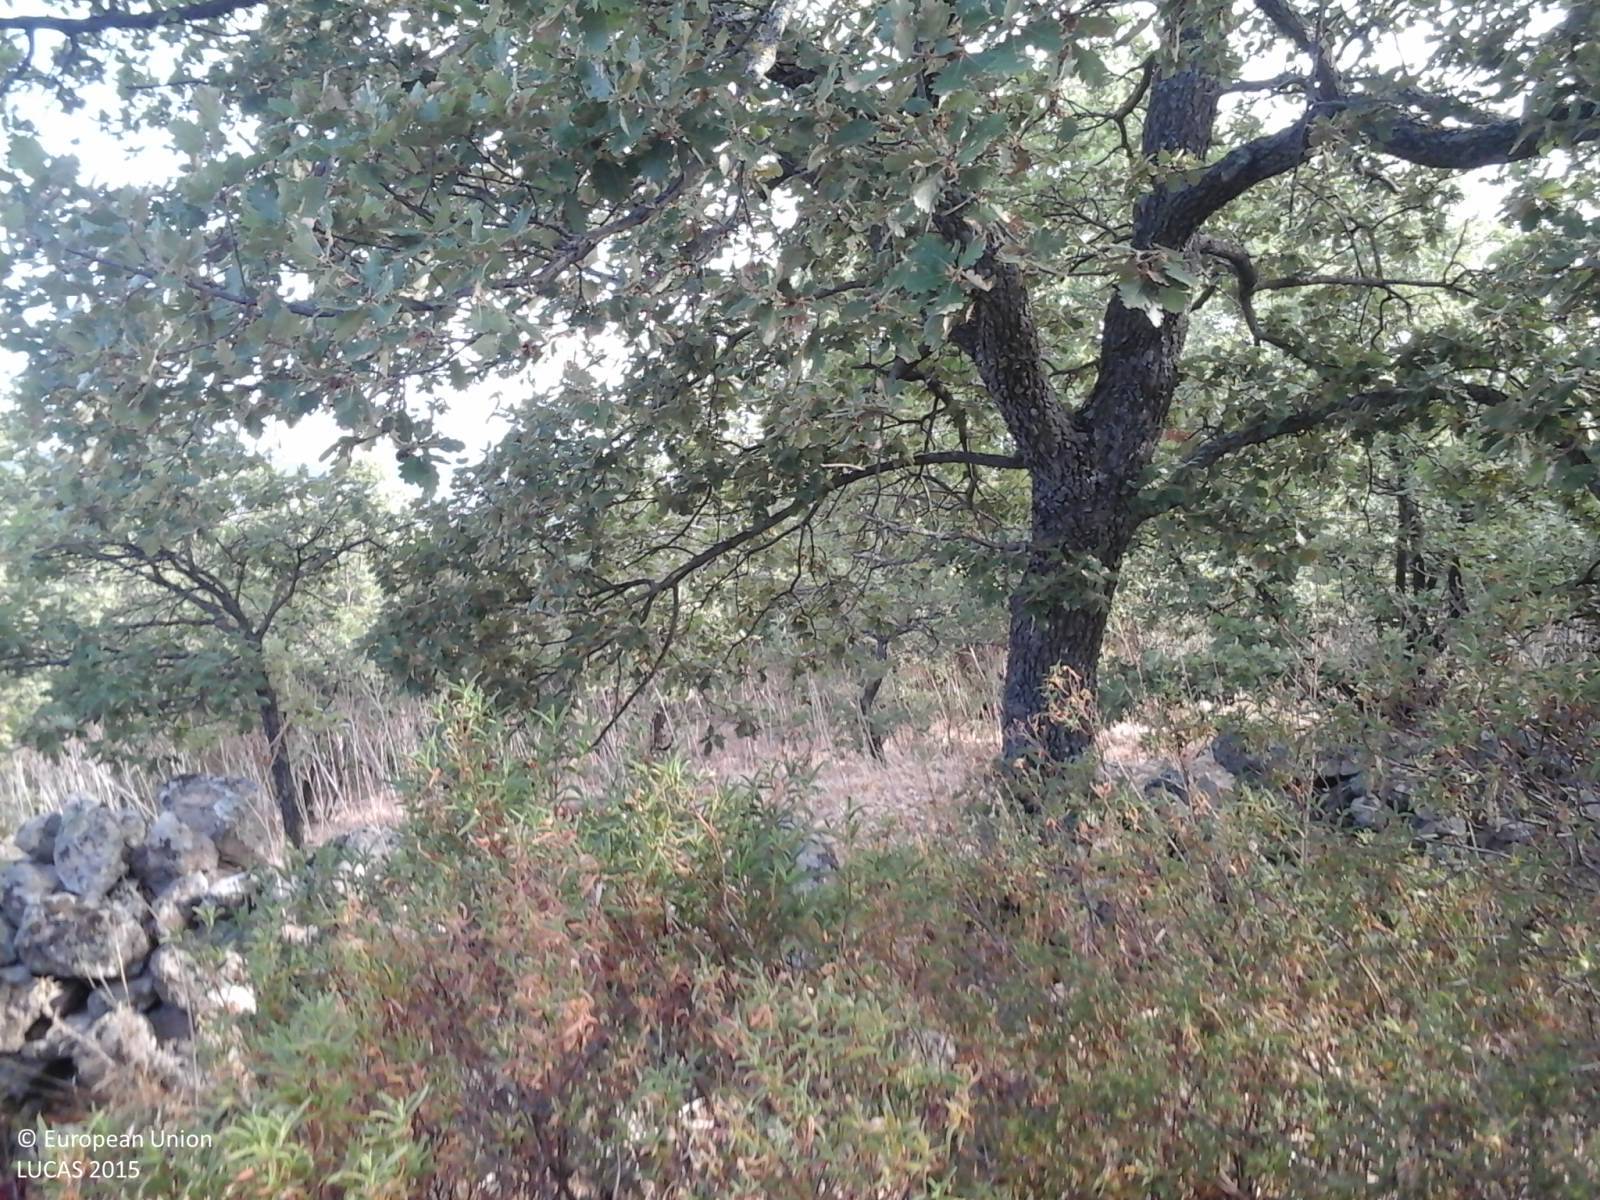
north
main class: Woodland
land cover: Broadleaved woodland
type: broadleaved evergreen forest
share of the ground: 25 - 50 %
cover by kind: herbaceous plants 45 %, broadleaved forest trees 30 %, shrubs 25 %
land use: Semi-natural and natural areas not in use
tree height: > 5 m
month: July
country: IT
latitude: 40.4420
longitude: 8.8857
